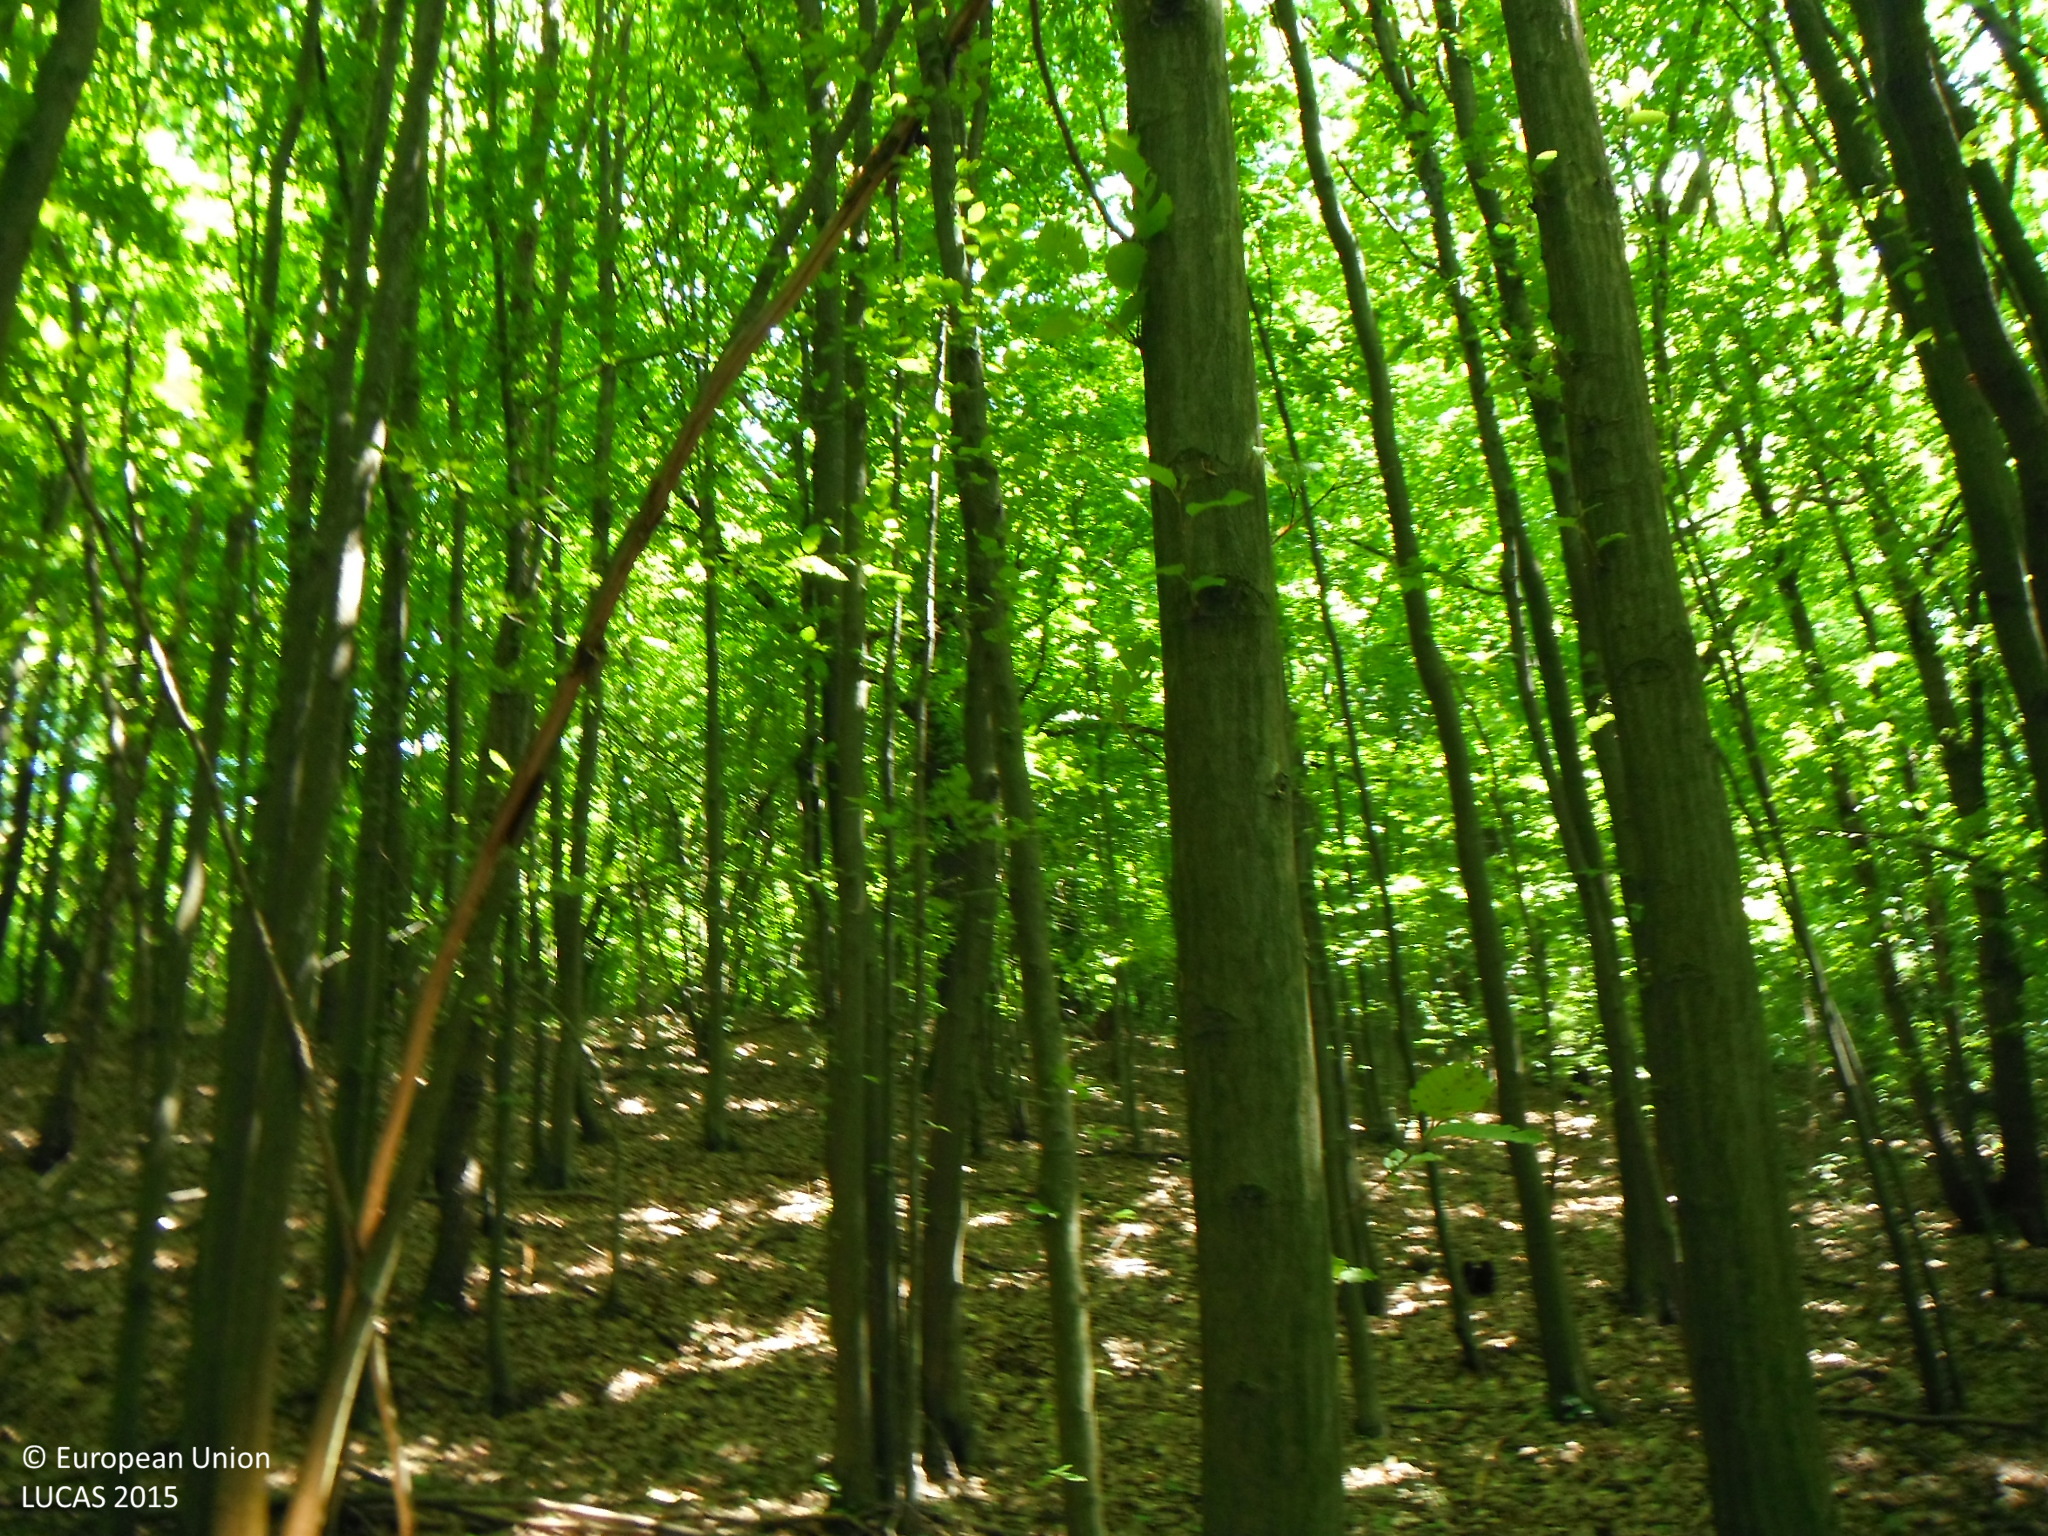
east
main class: Woodland
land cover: Broadleaved woodland
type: mesophytic deciduous forest
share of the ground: > 75 %
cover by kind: broadleaved forest trees 100 %
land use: Forestry
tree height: > 5 m
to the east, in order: Broadleaved woodland; Tracks; Broadleaved woodland; Grassland without tree/shrub cover
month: May
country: SK
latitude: 49.1145
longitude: 21.6272
